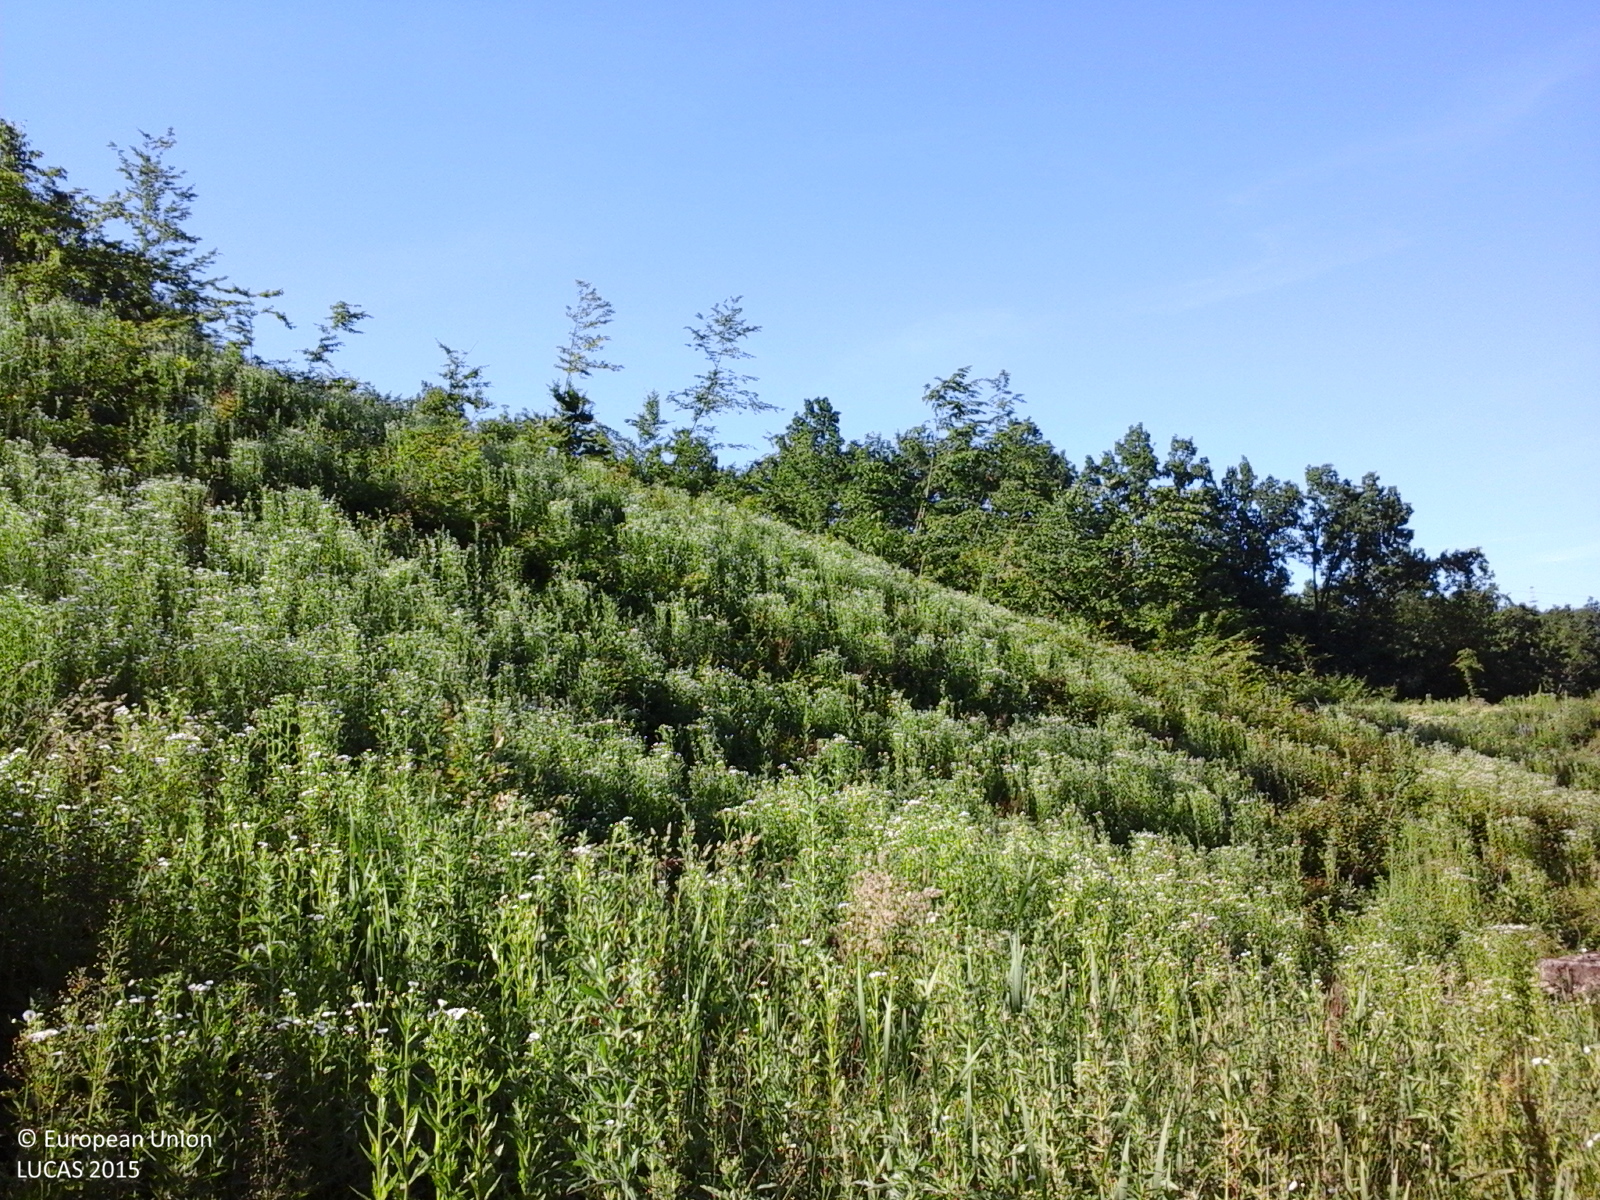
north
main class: Grassland
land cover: Spontaneously vegetated surfaces
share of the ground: > 75 %
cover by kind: herbaceous plants 100 %
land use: Forestry
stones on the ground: < 10 %
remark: Clear cut
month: June
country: RO
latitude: 45.1083
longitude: 25.8271
